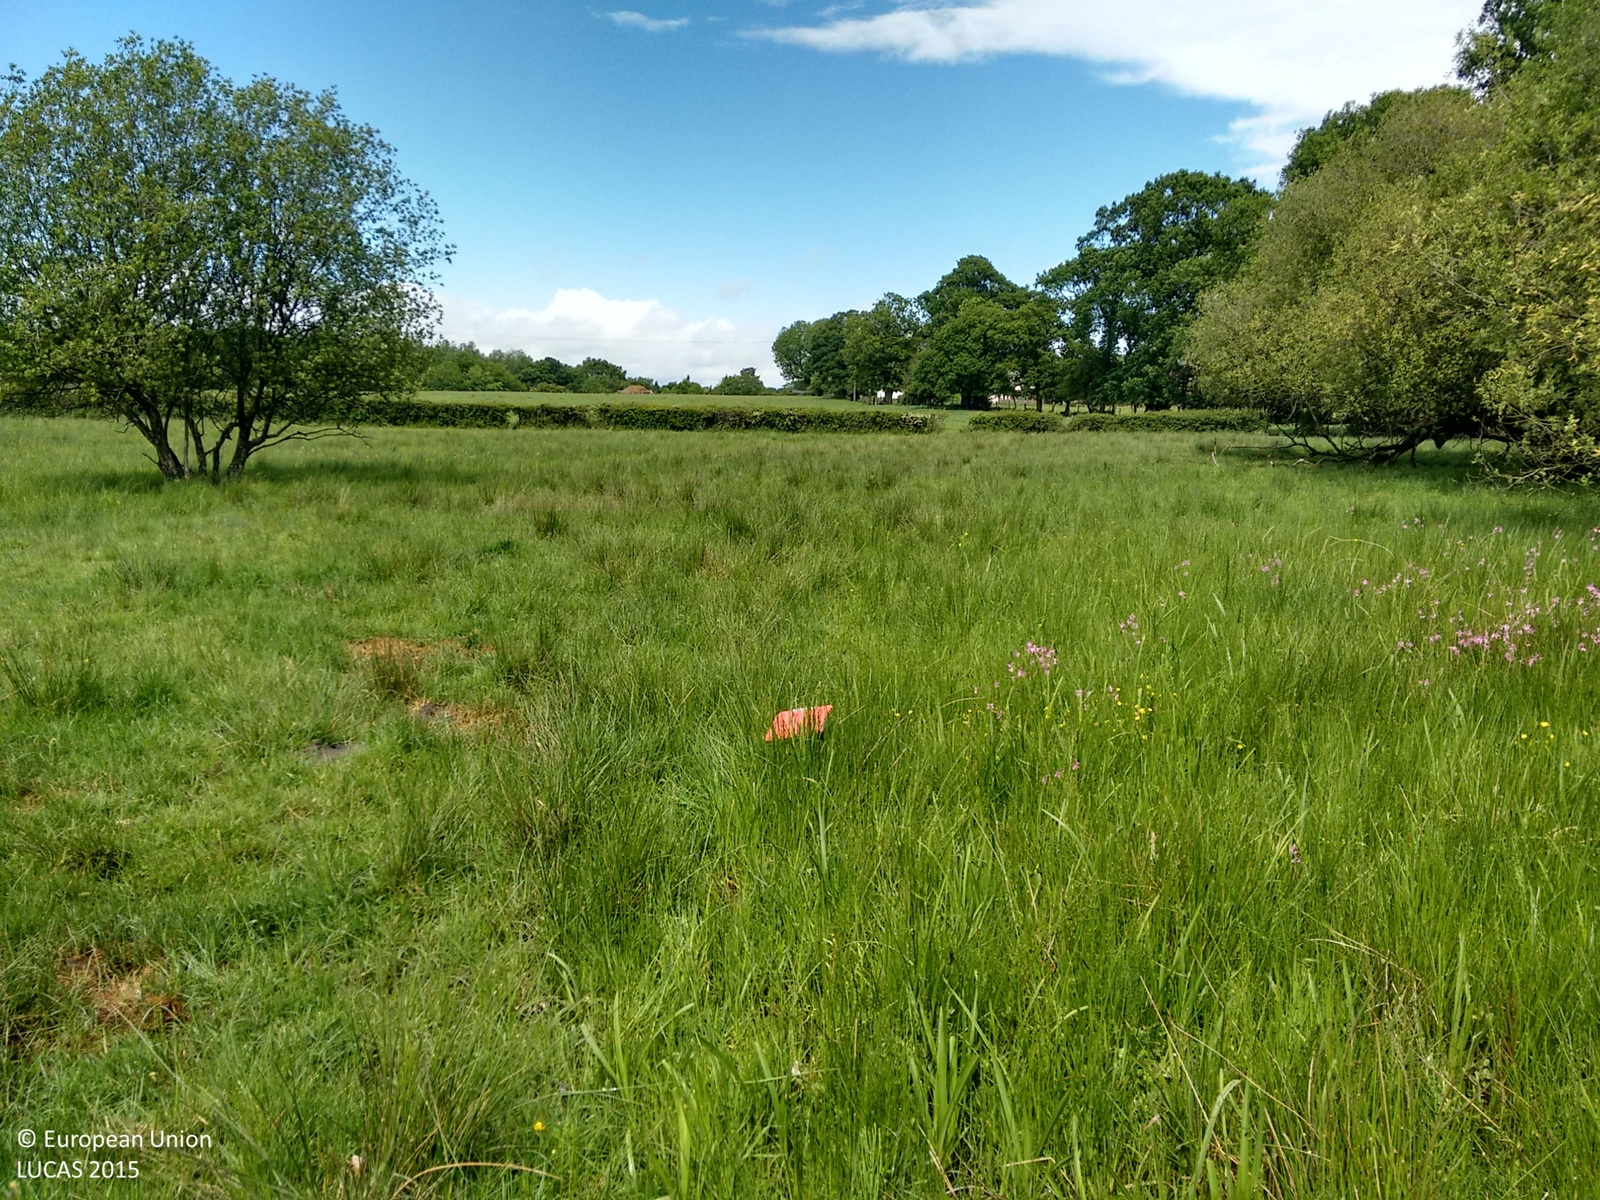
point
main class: Grassland
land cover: Grassland with sparse tree/shrub cover
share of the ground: > 75 %
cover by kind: herbaceous plants 95 %, broadleaved forest trees 5 %
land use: Agriculture (excluding fallow land and kitchen gardens)
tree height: > 5 m
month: May
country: GB
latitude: 51.0202
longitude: -1.4696
